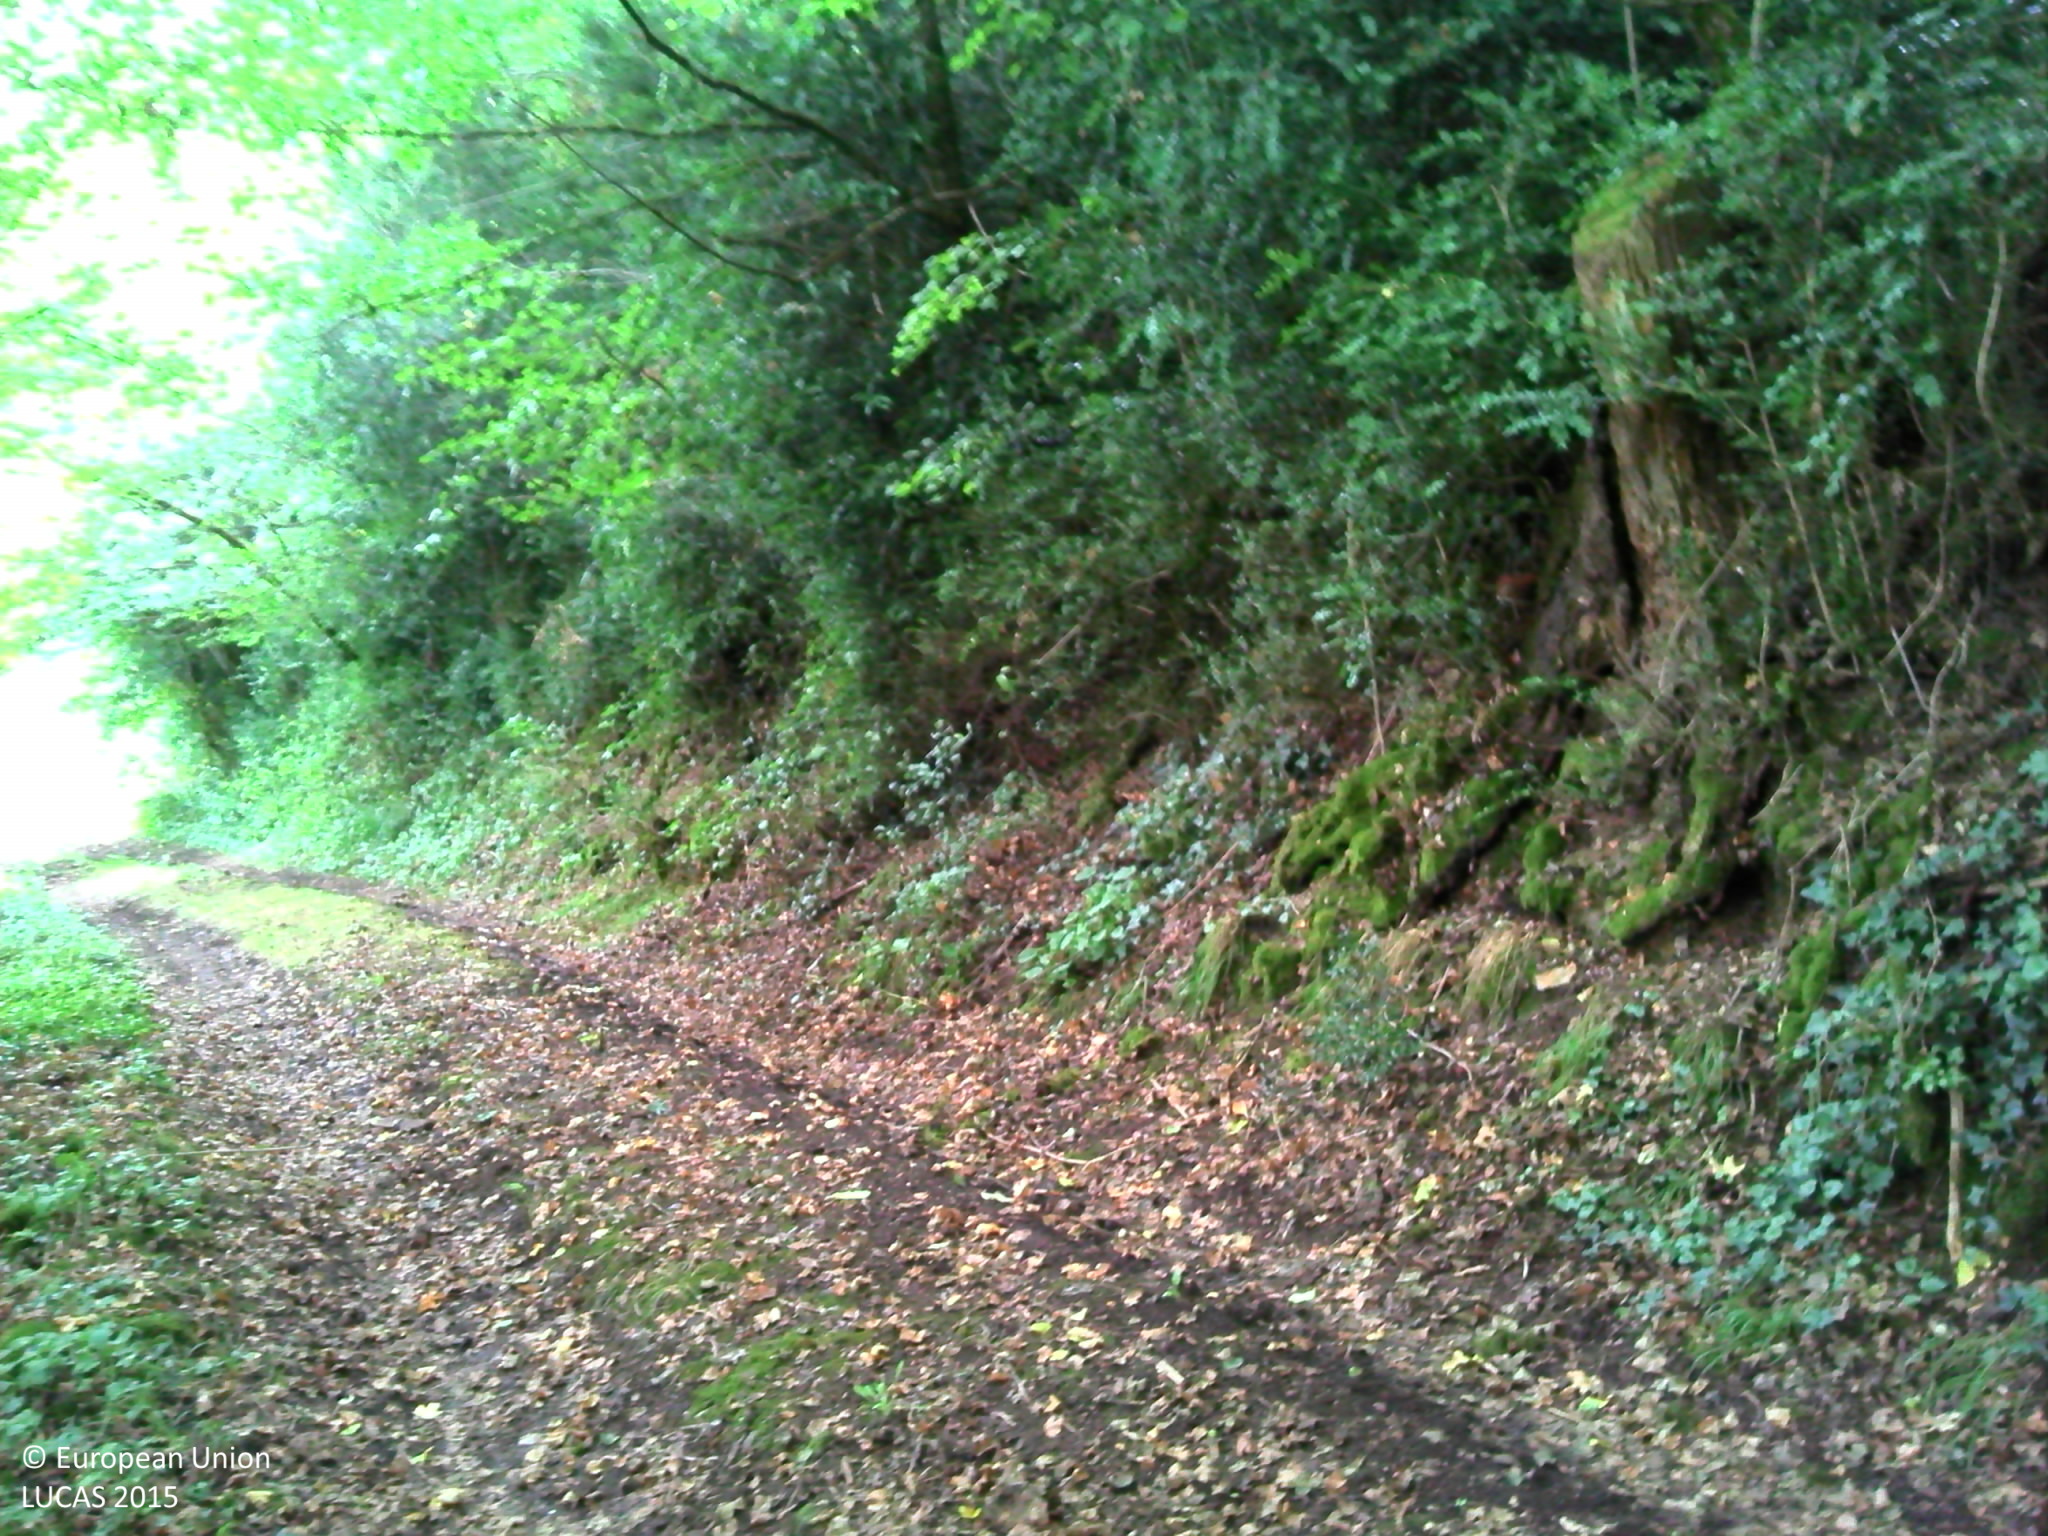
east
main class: Woodland
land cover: Broadleaved woodland
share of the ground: > 75 %
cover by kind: shrubs 60 %, broadleaved forest trees 20 %, herbaceous plants 20 %
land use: Semi-natural and natural areas not in use
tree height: < 5 m
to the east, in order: Broadleaved woodland; Tracks; Broadleaved woodland; Grass margins; Grassland without tree/shrub cover; Grass margins; Broadleaved woodland
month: August
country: FR
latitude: 46.1509
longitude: 0.3628
